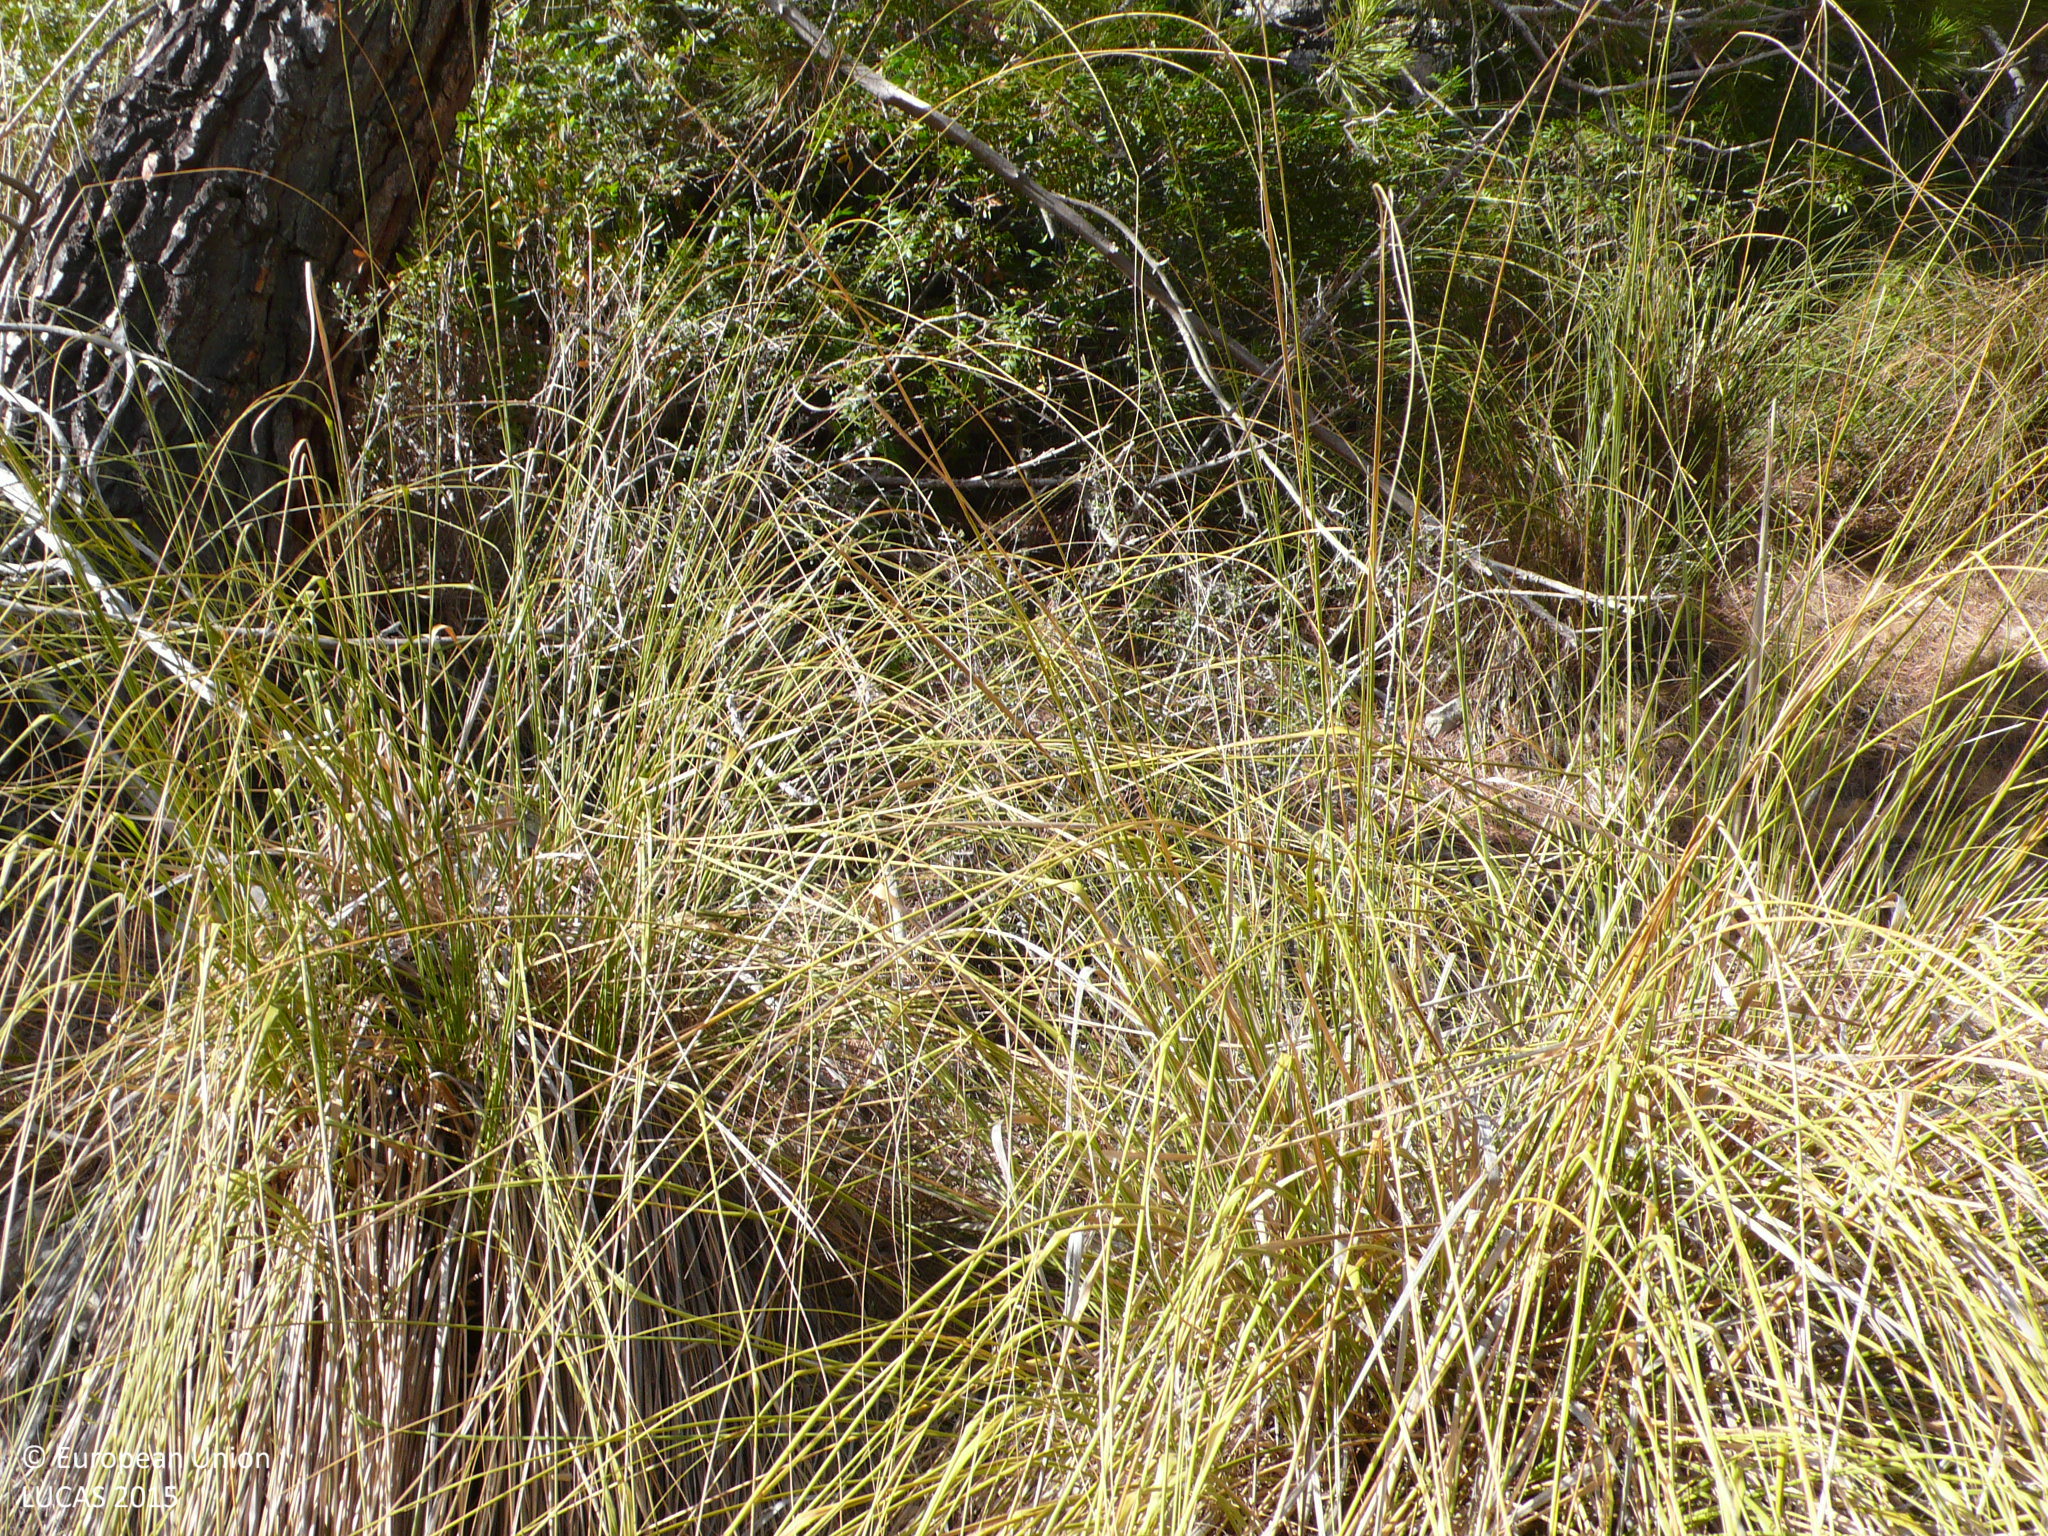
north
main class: Woodland
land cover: Pine dominated mixed woodland
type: coniferous forest of the mediterranean region
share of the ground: 50 - 75 %
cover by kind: coniferous forest trees 40 %, consolidated bare surface 25 %, shrubs 20 %, broadleaved forest trees 15 %
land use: Semi-natural and natural areas not in use
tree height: > 5 m
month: August
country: ES
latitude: 39.5584
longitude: 2.4540
